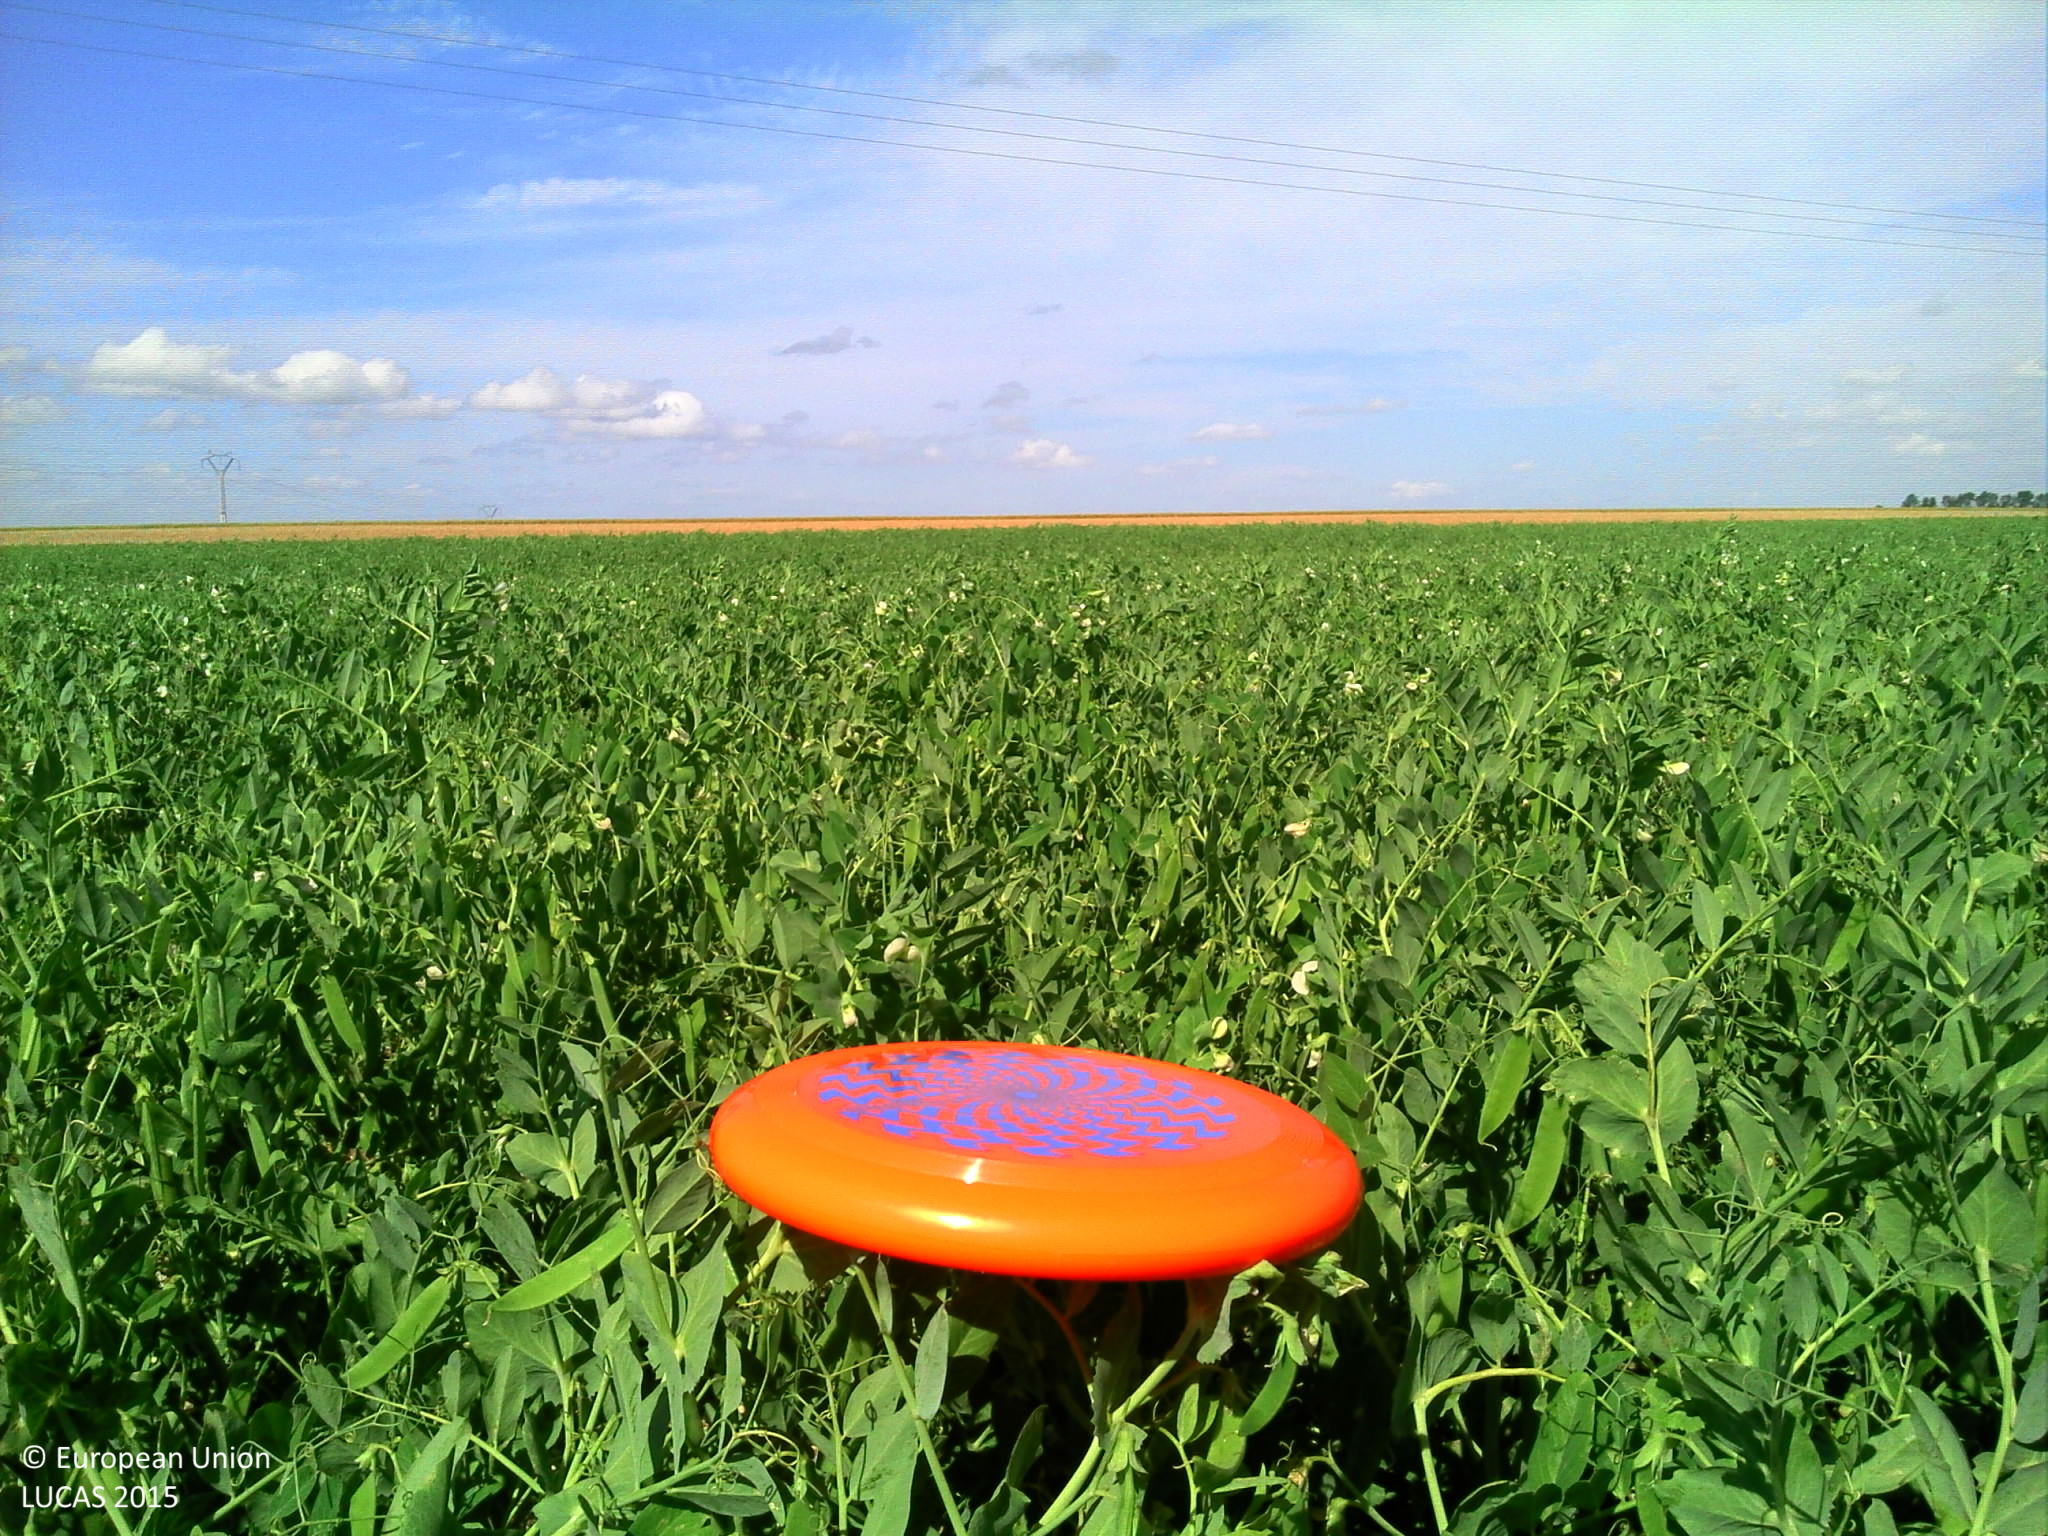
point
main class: Cropland
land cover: Dry pulses
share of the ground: > 75 %
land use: Agriculture (excluding fallow land and kitchen gardens)
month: June
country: FR
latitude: 46.2936
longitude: -0.9737
